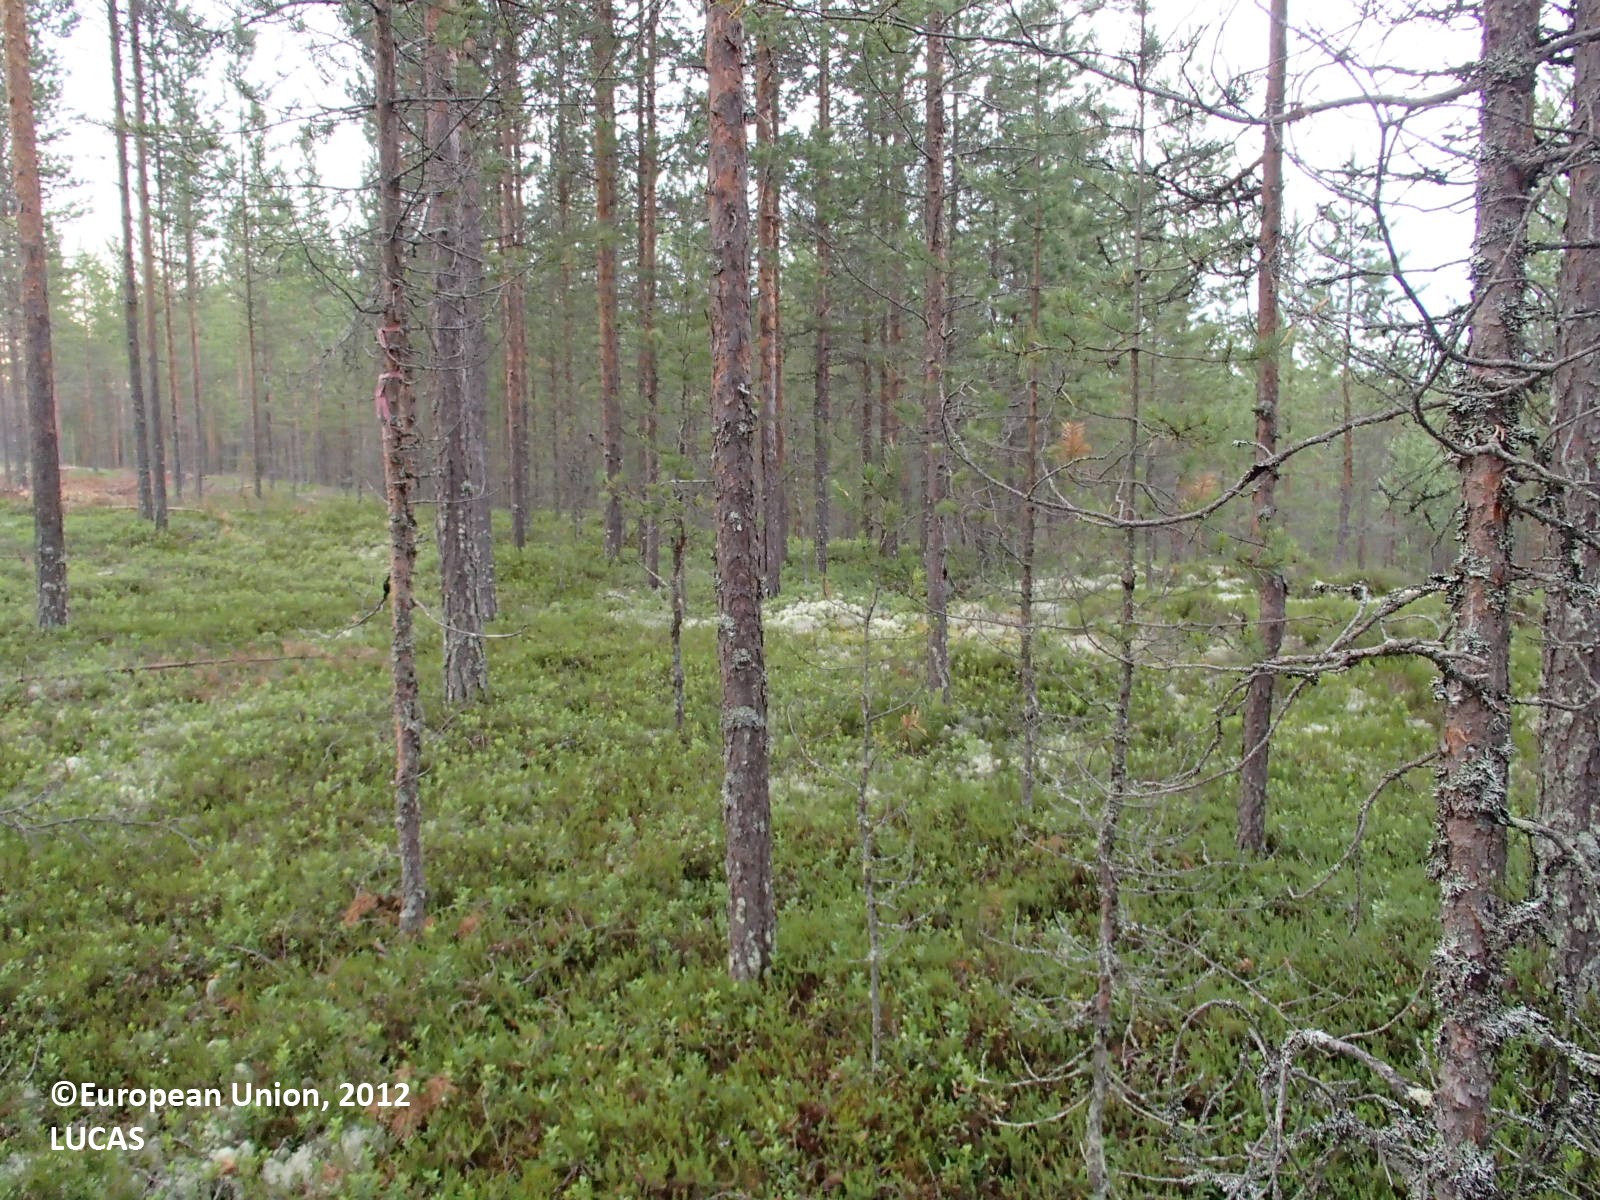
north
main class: Woodland
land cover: Pine dominated coniferous woodland
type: boreal forest
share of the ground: 50 - 75 %
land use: Forestry
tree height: > 5 m
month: July
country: FI
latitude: 64.3241
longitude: 26.3086
